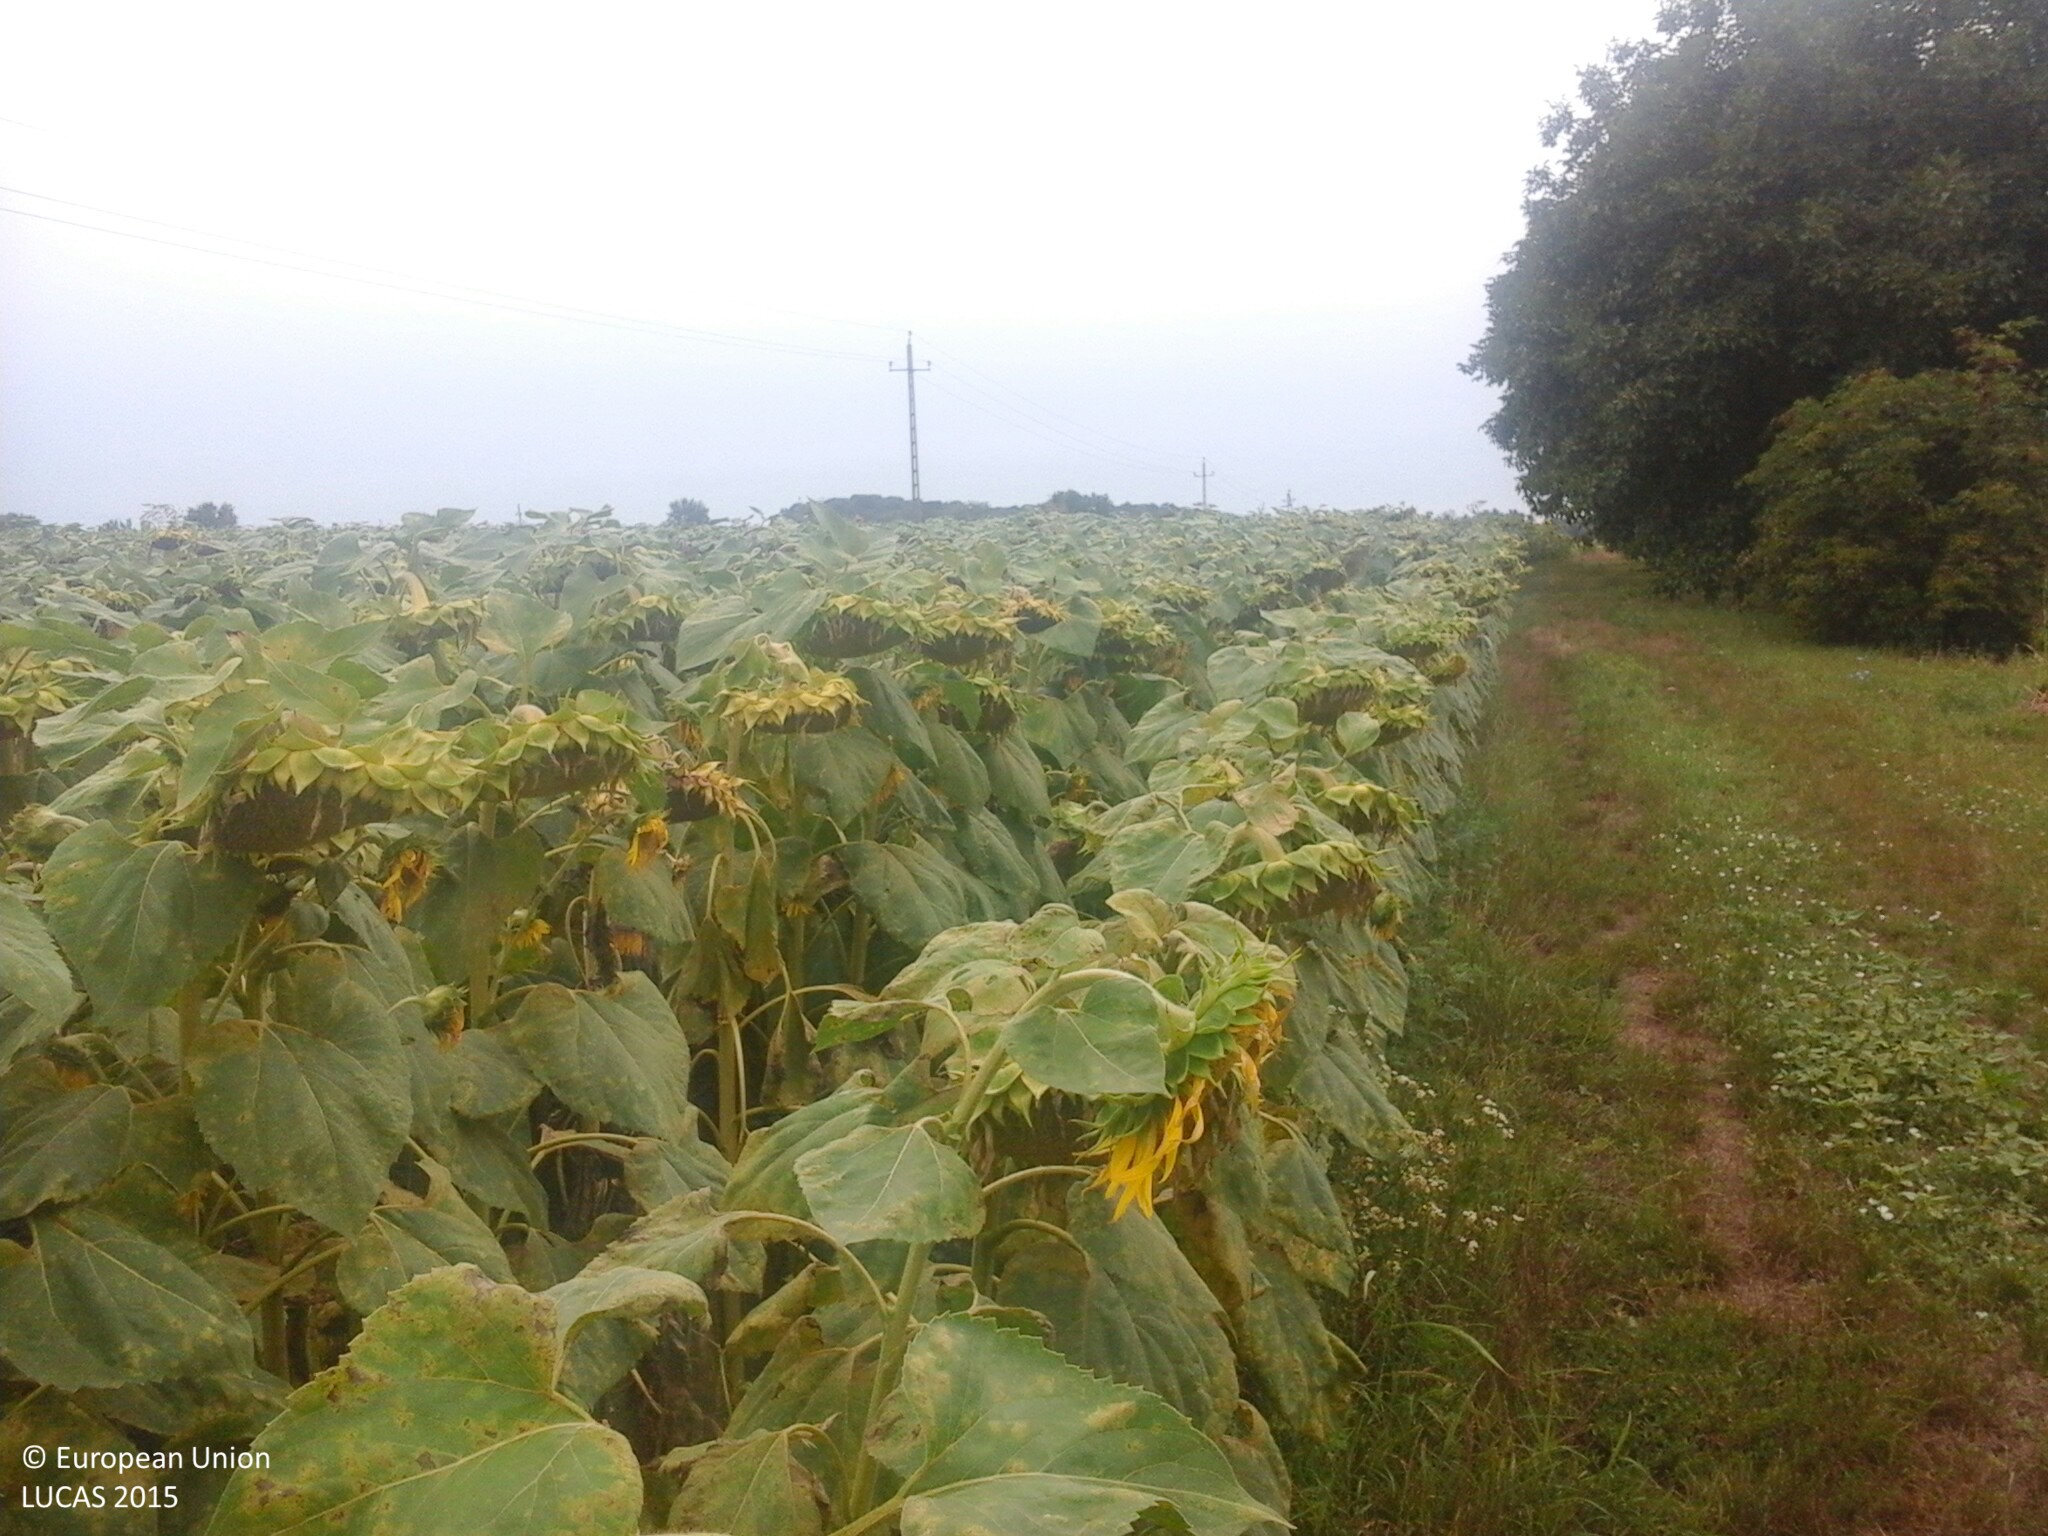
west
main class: Cropland
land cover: Sunflower
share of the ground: > 75 %
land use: Agriculture (excluding fallow land and kitchen gardens)
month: July
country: HU
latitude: 47.0125
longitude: 18.4437
